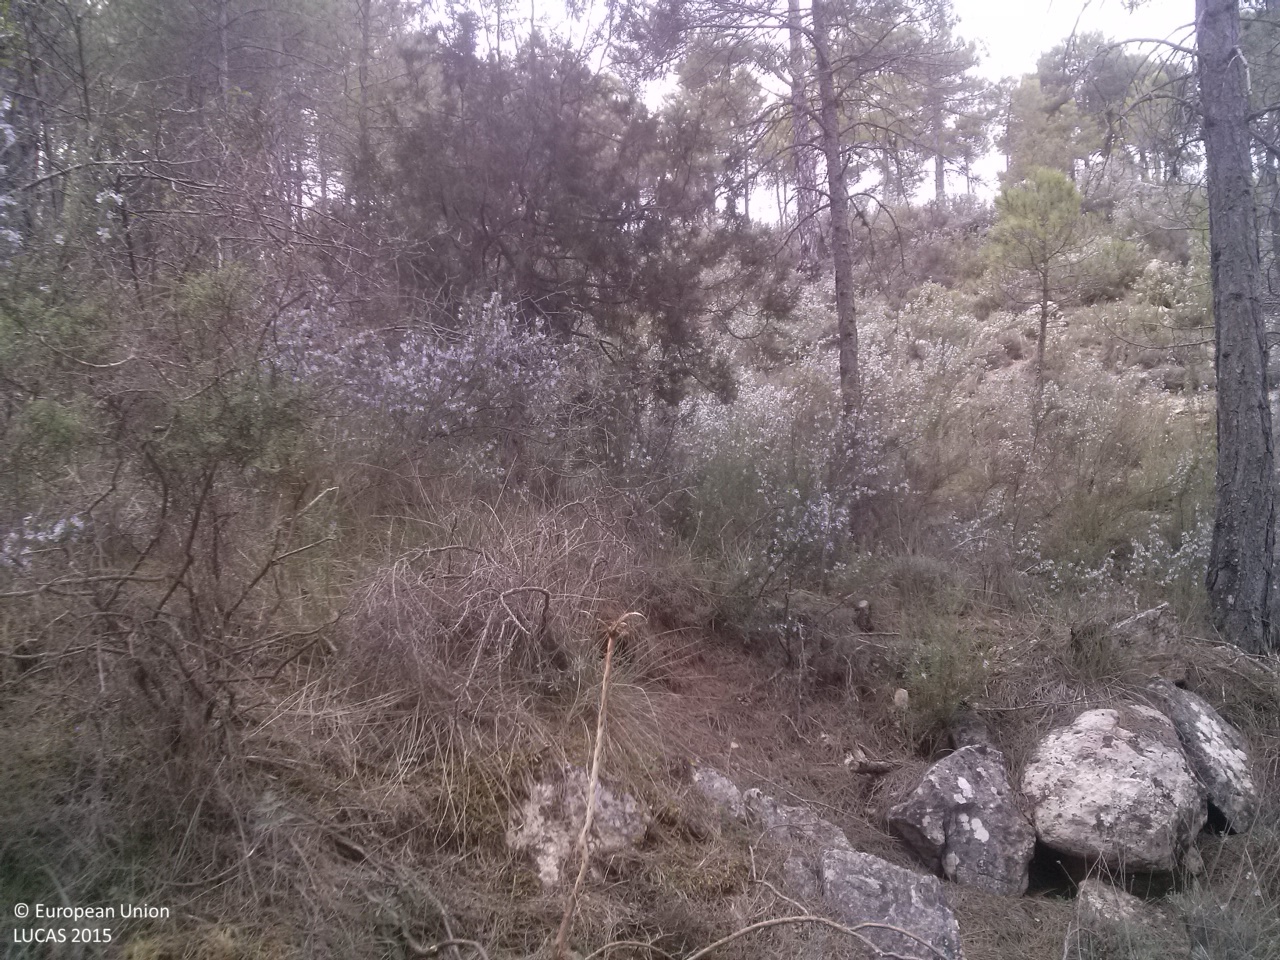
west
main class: Woodland
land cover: Pine dominated coniferous woodland
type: coniferous forest of the mediterranean region
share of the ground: 50 - 75 %
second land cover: Shrubland without tree cover
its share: 50 - 75 %
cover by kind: coniferous forest trees 75 %, herbaceous plants 20 %, shrubs 5 %
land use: Forestry
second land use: Agriculture (excluding fallow land and kitchen gardens)
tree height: > 5 m
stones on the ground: < 10 %
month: April
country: ES
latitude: 39.9969
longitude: -1.9013
